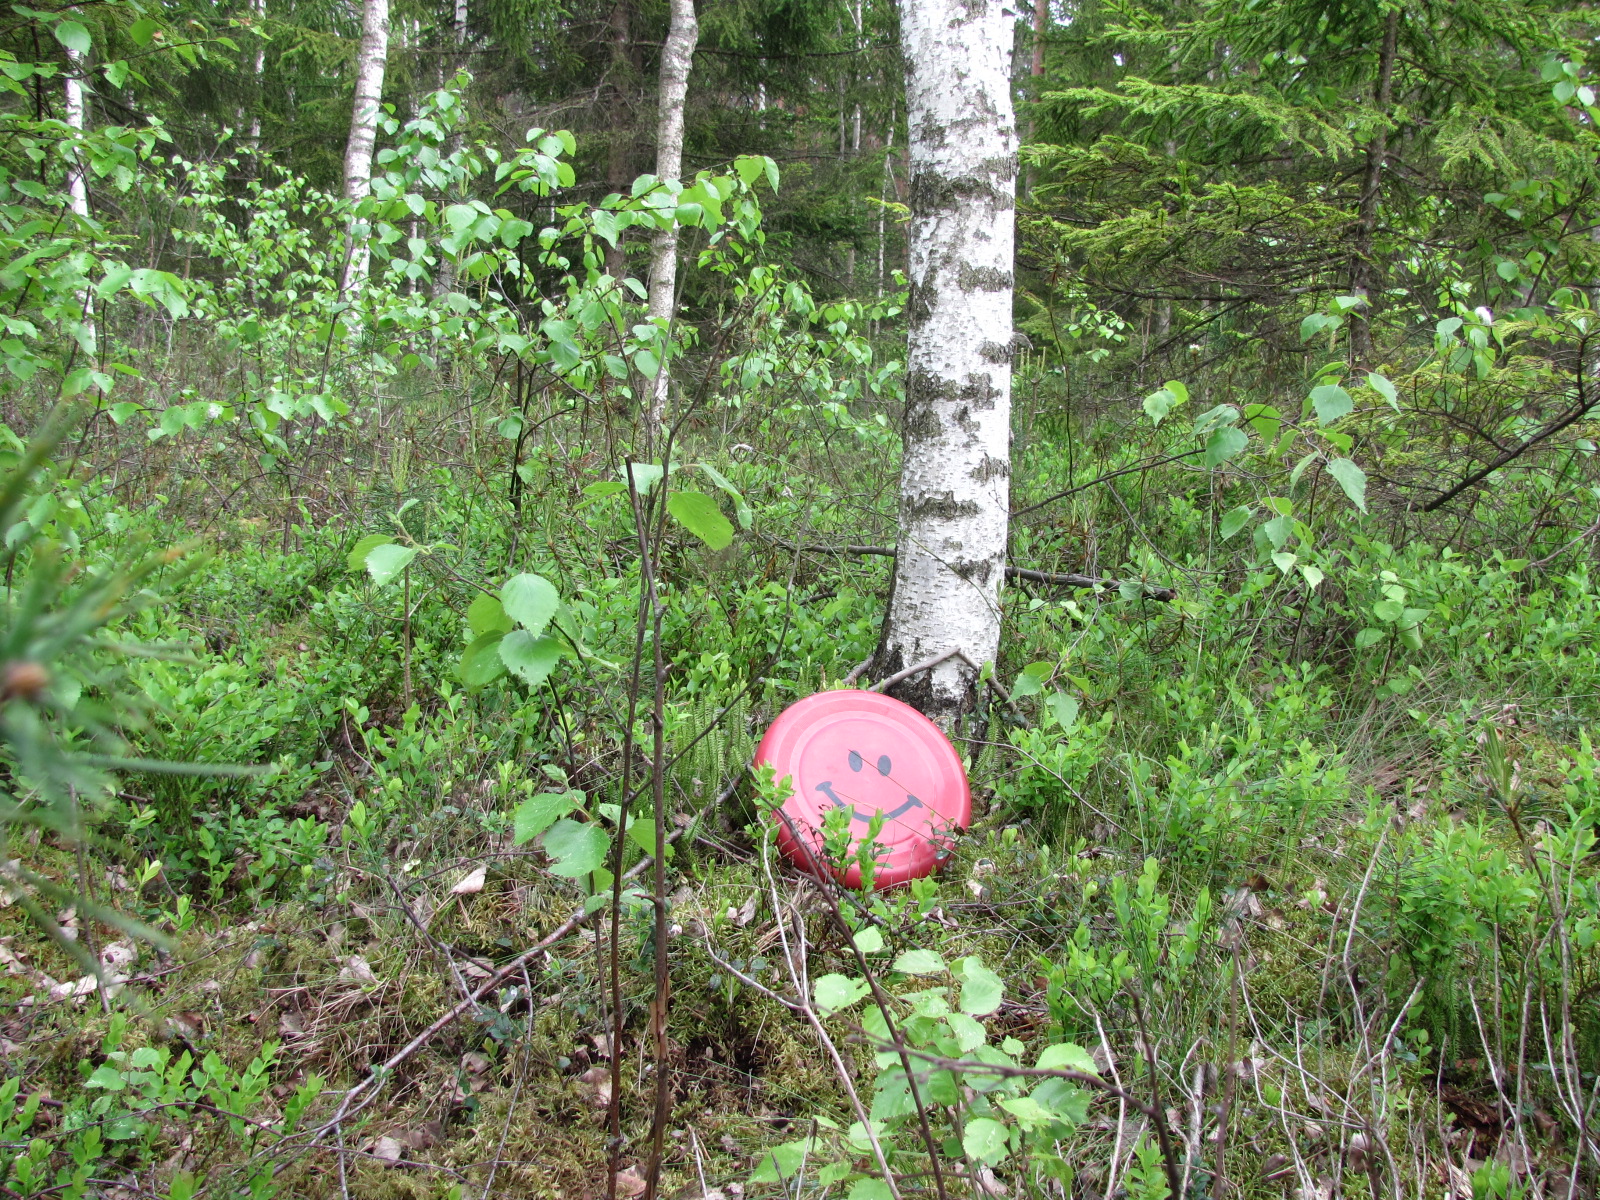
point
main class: Woodland
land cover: Spruce dominated mixed woodland
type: hemiboreal forest and nemoral coniferous forest and mixed broadleaved-coniferous forest
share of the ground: 50 - 75 %
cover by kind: coniferous forest trees 30 %, broadleaved forest trees 30 %, herbaceous plants 20 %, lichens and mosses 20 %
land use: Forestry
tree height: > 5 m
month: June
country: LV
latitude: 56.6442
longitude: 24.2944
